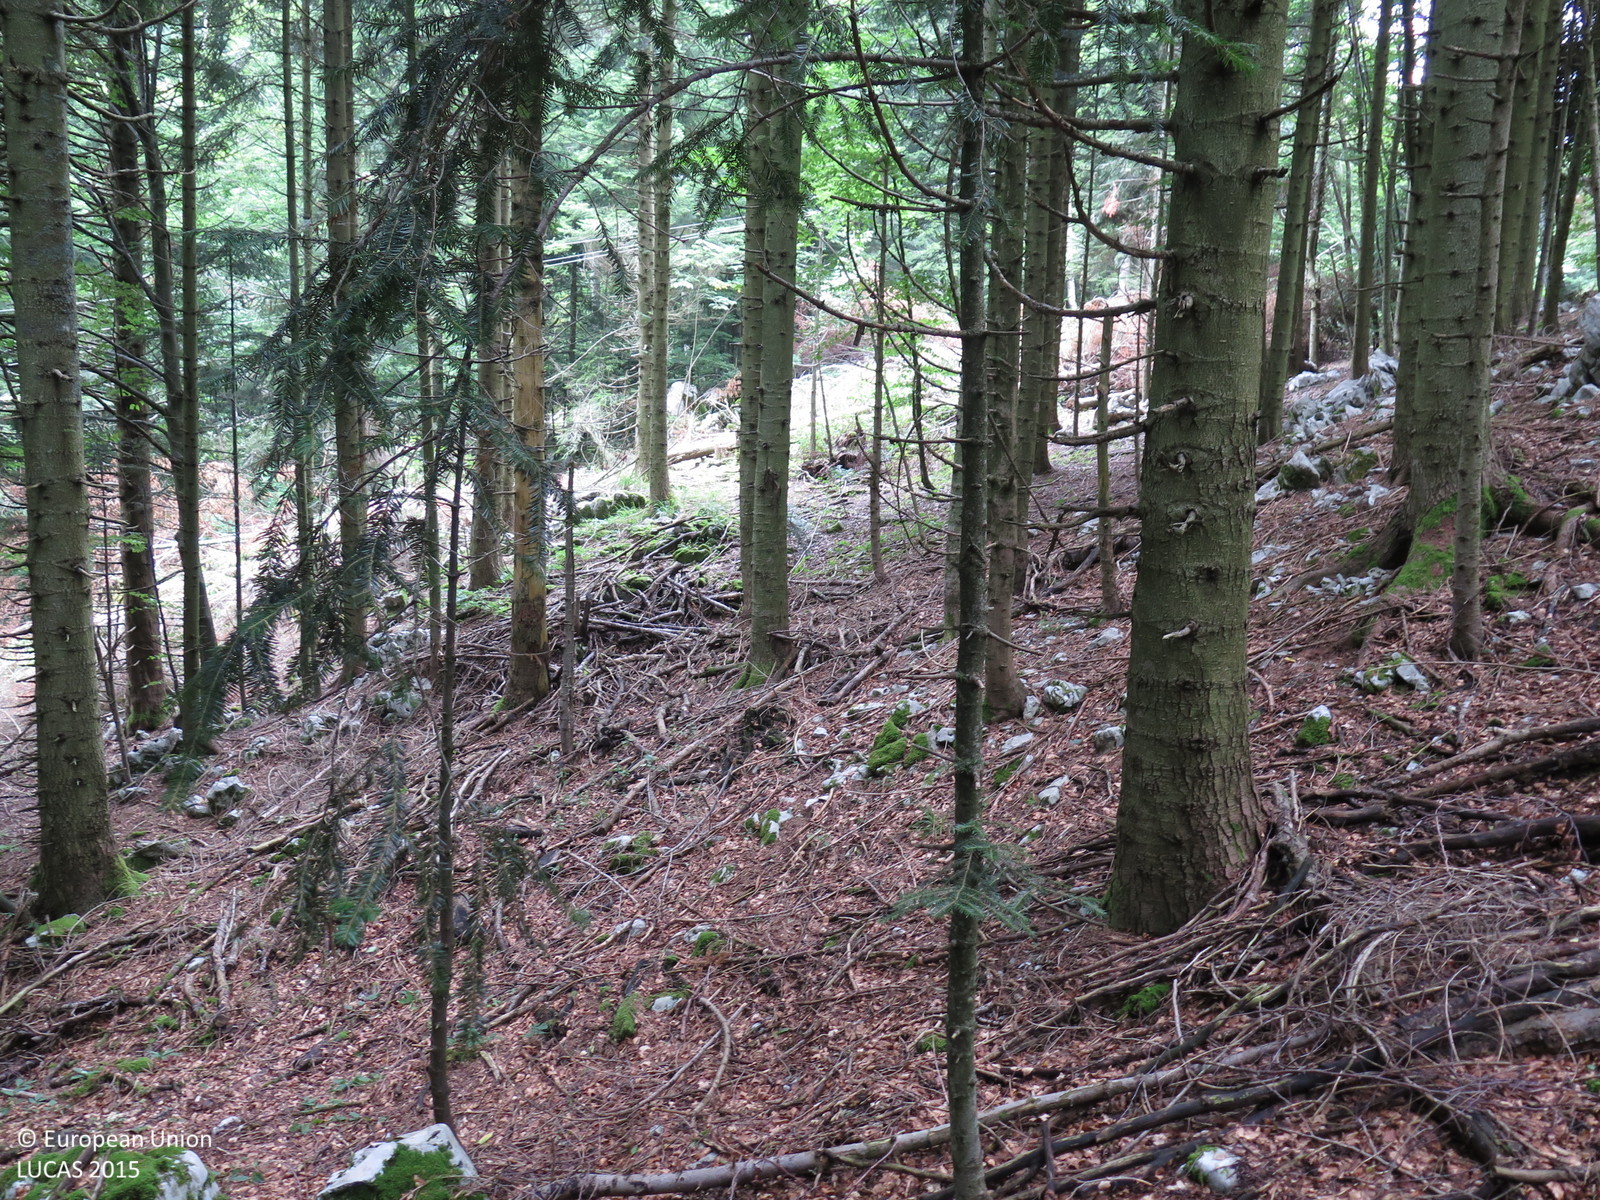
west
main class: Woodland
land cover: Other coniferous woodland
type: alpine coniferous forest
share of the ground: > 75 %
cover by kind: coniferous forest trees 75 %, broadleaved forest trees 25 %
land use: Forestry
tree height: > 5 m
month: August
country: HR
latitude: 45.0808
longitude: 14.9617
